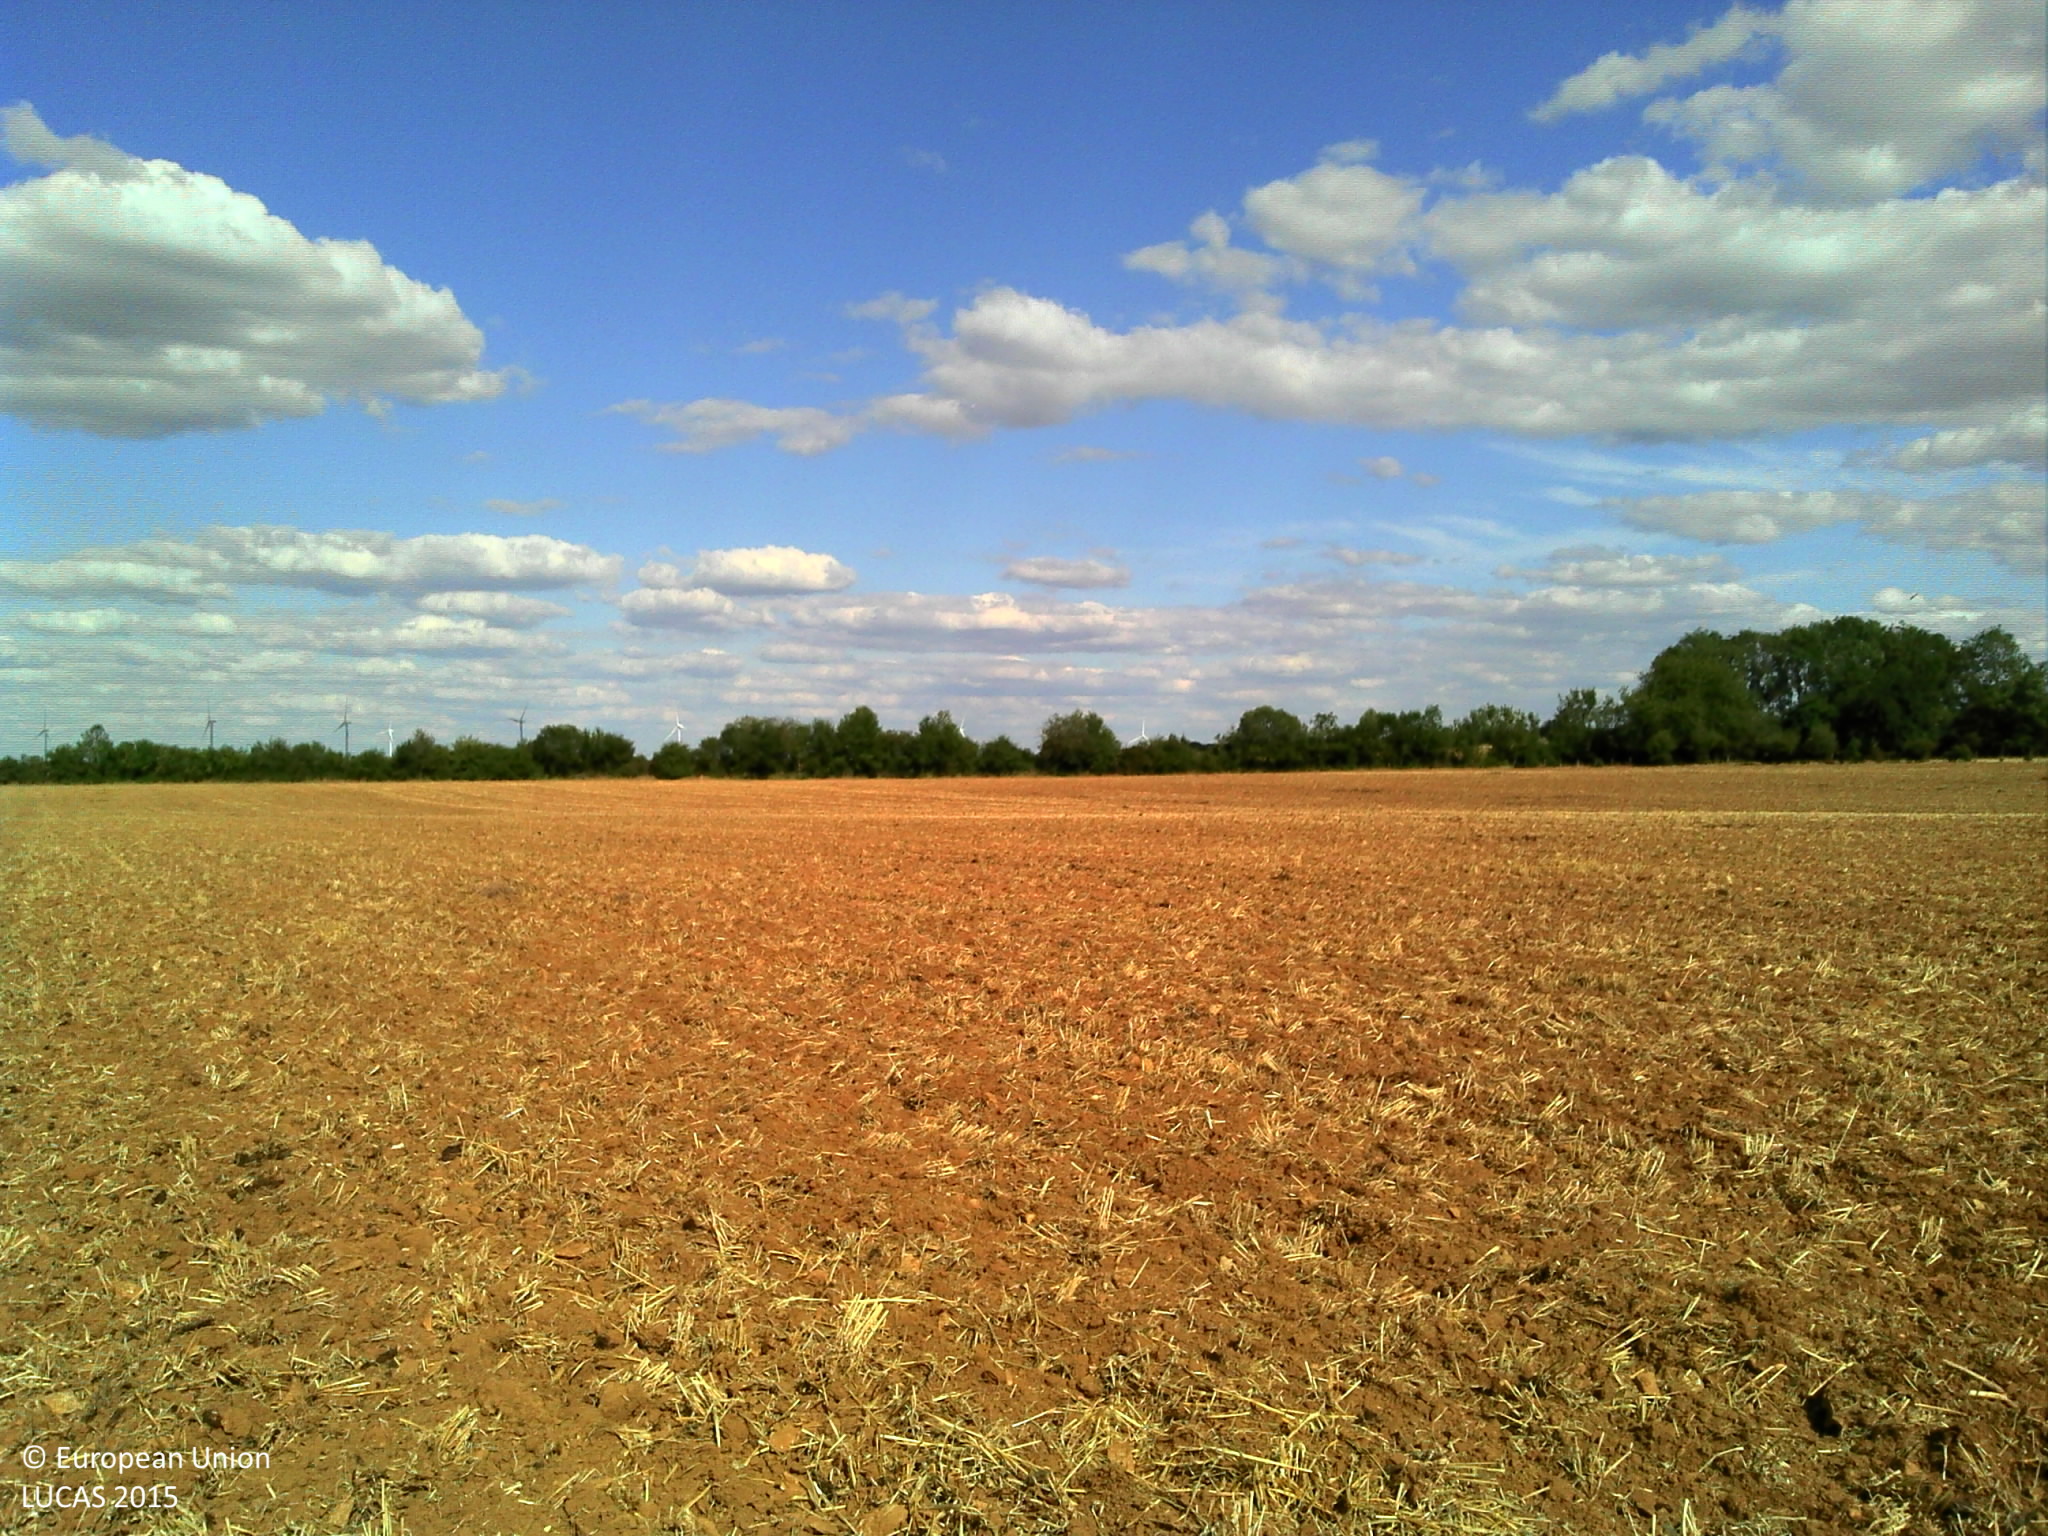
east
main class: Cropland
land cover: Barley
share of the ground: 10 - 25 %
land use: Agriculture (excluding fallow land and kitchen gardens)
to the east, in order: Barley
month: July
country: FR
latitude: 47.7219
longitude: 5.1874
